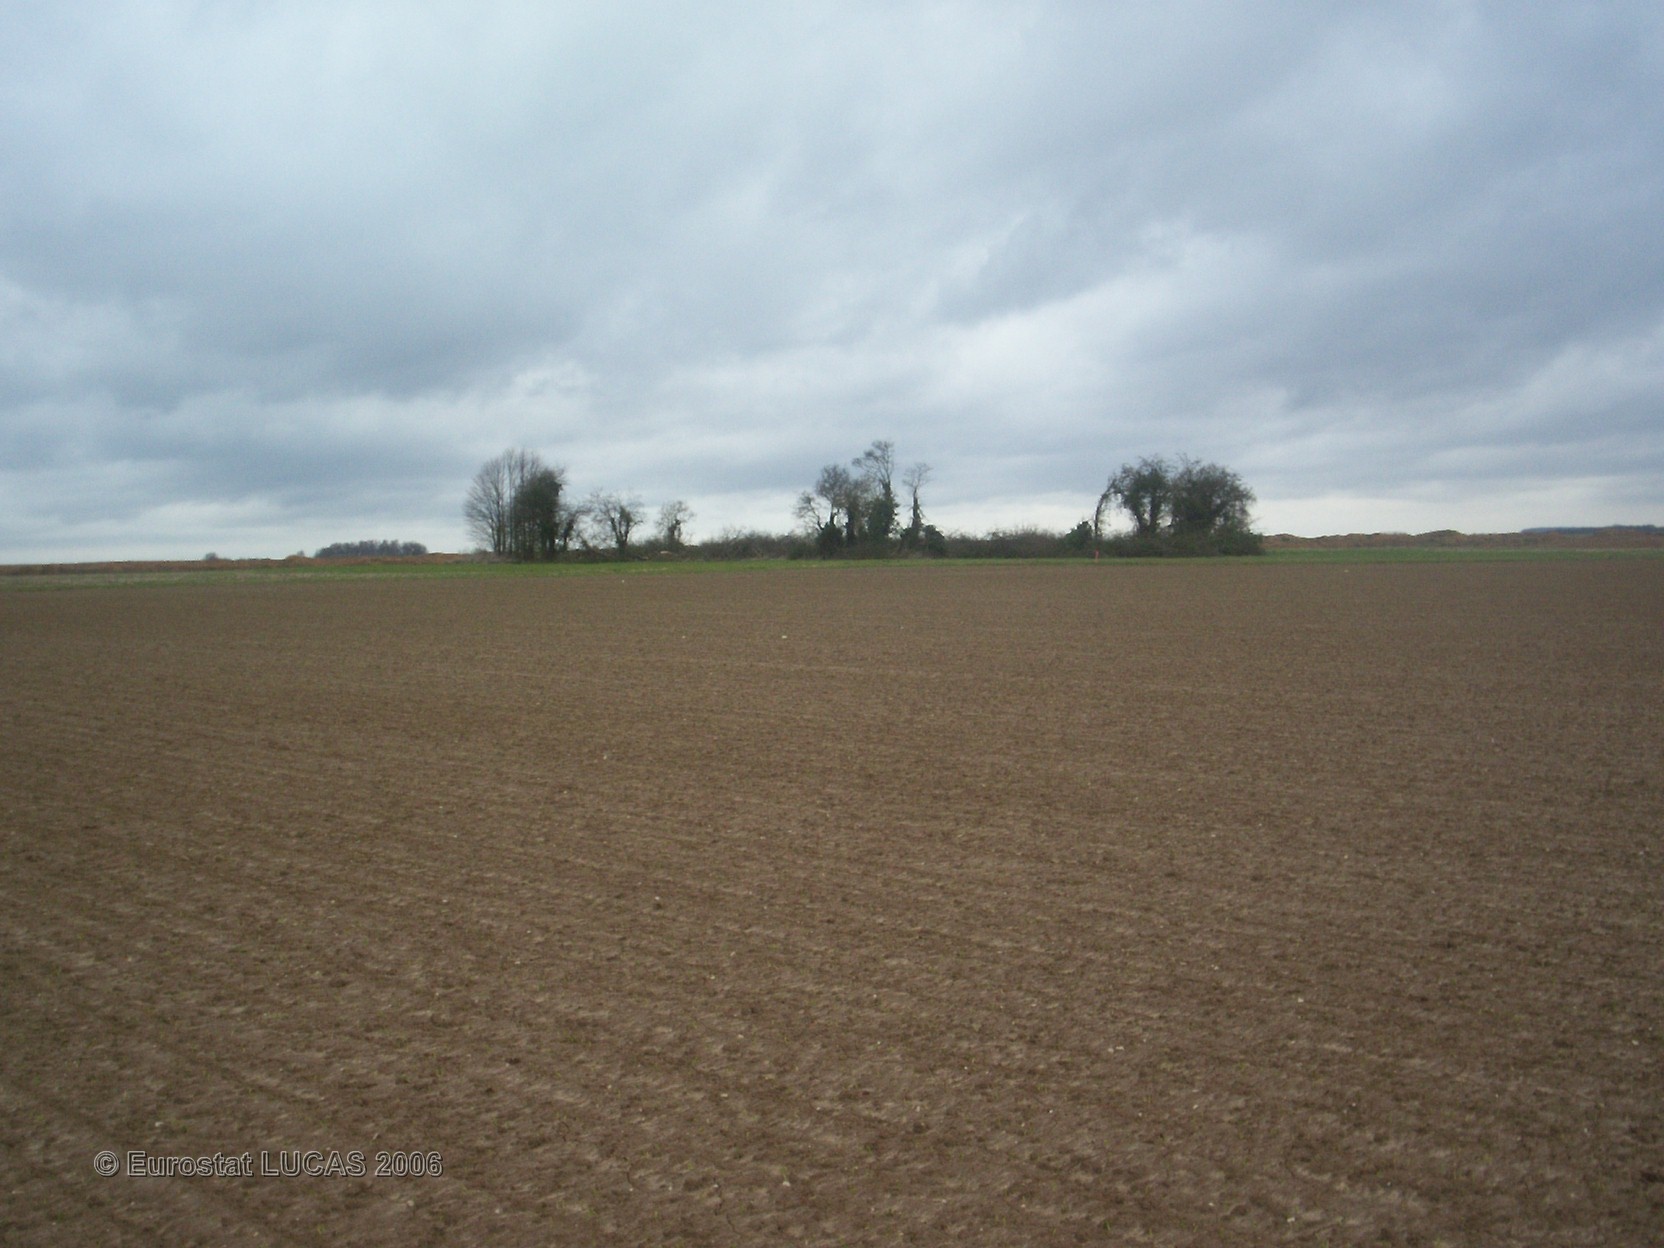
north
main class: Cropland
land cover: Maize
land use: Agriculture (excluding fallow land and kitchen gardens)
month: April
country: FR
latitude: 49.9680
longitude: 2.6971
